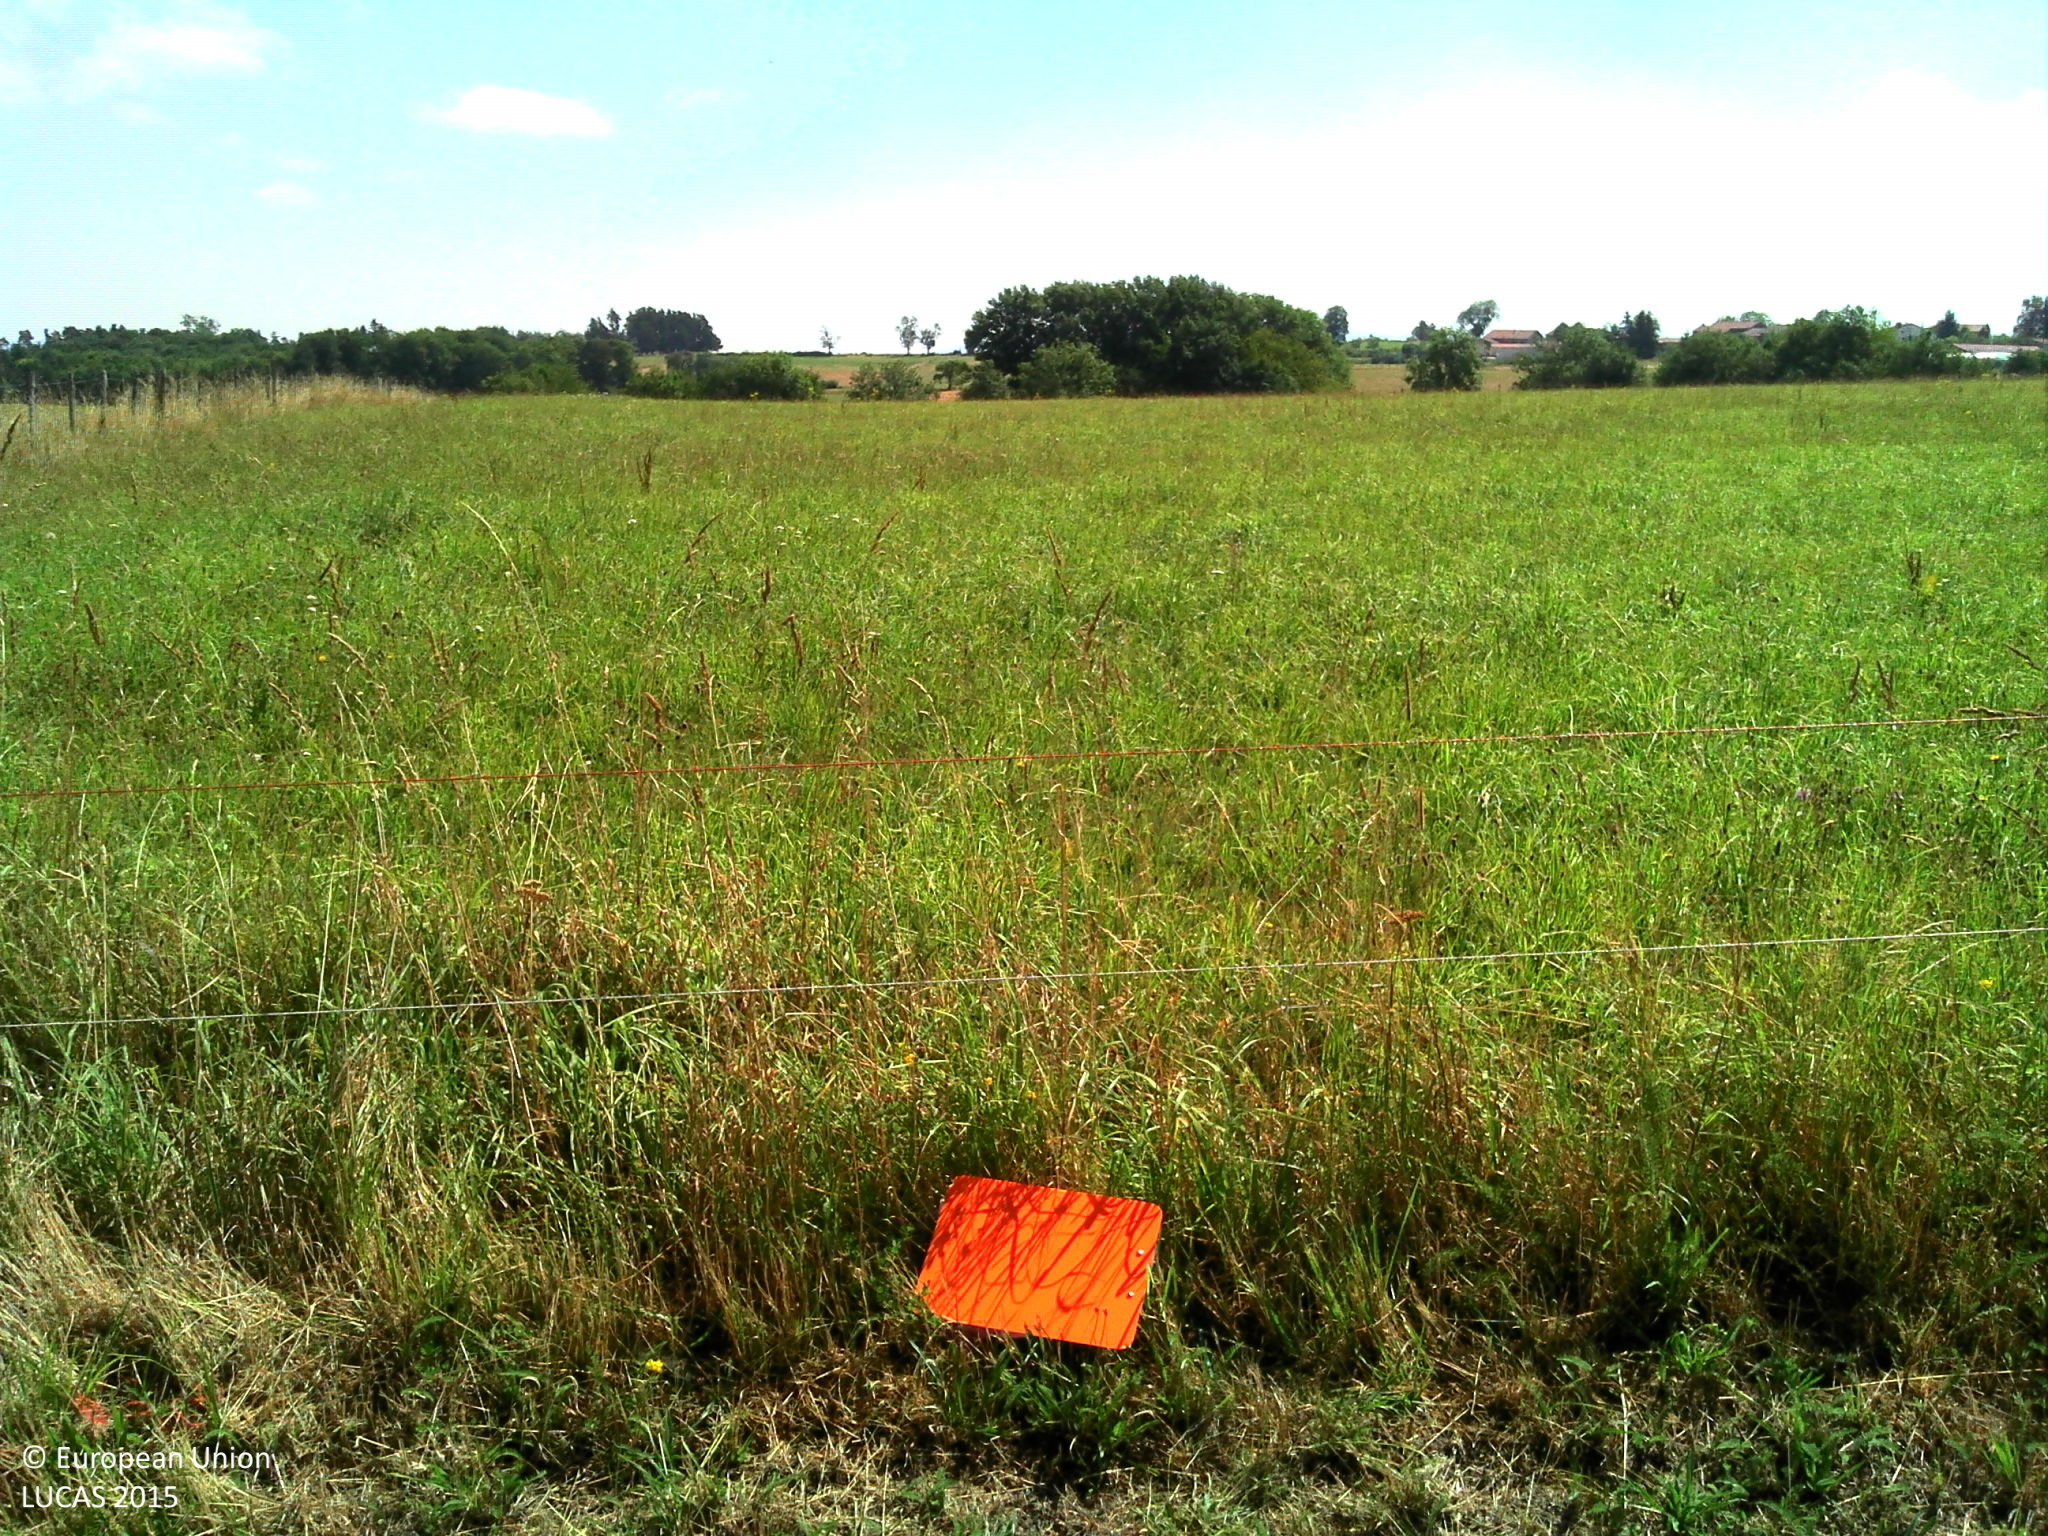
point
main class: Grassland
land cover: Grassland without tree/shrub cover
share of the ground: > 75 %
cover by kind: herbaceous plants 100 %
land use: Agriculture (excluding fallow land and kitchen gardens)
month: August
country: FR
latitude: 45.4180
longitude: 4.2146
